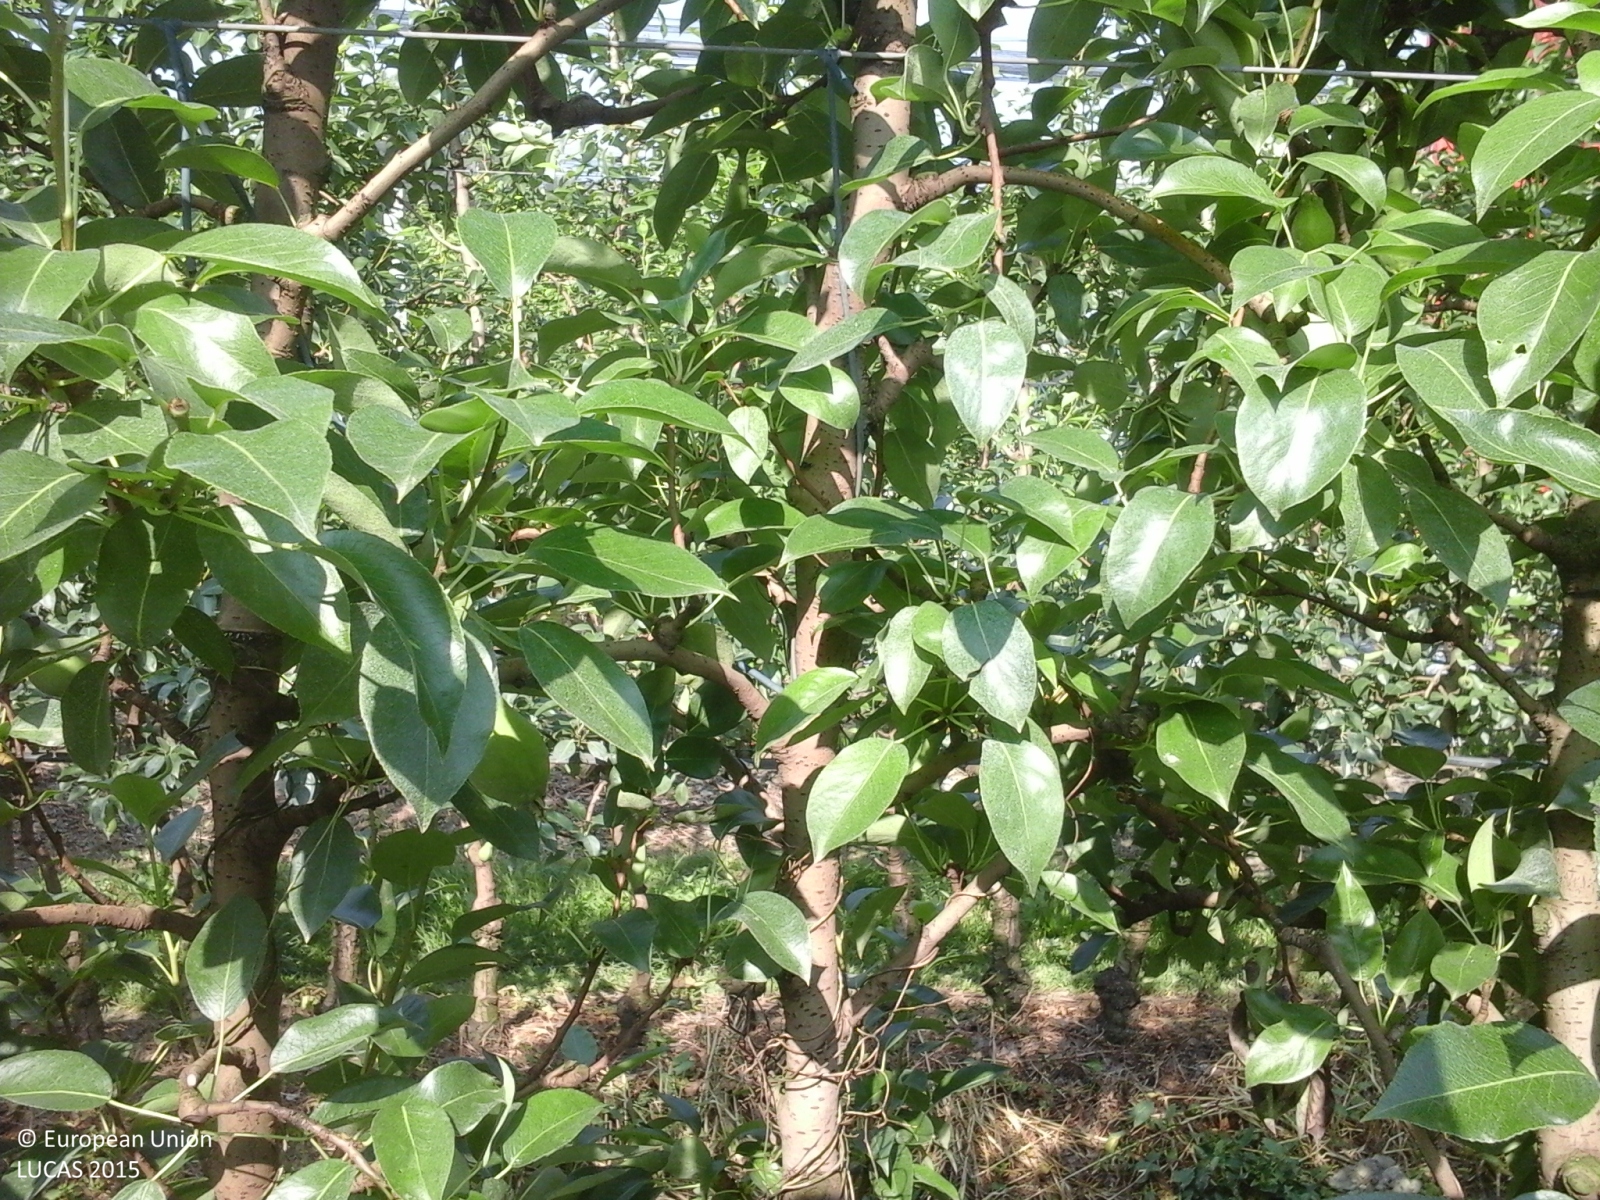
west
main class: Cropland
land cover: Pear fruit
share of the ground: 50 - 75 %
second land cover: Grassland without tree/shrub cover
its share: 50 - 75 %
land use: Agriculture (excluding fallow land and kitchen gardens)
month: May
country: IT
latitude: 44.8420
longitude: 11.6793
